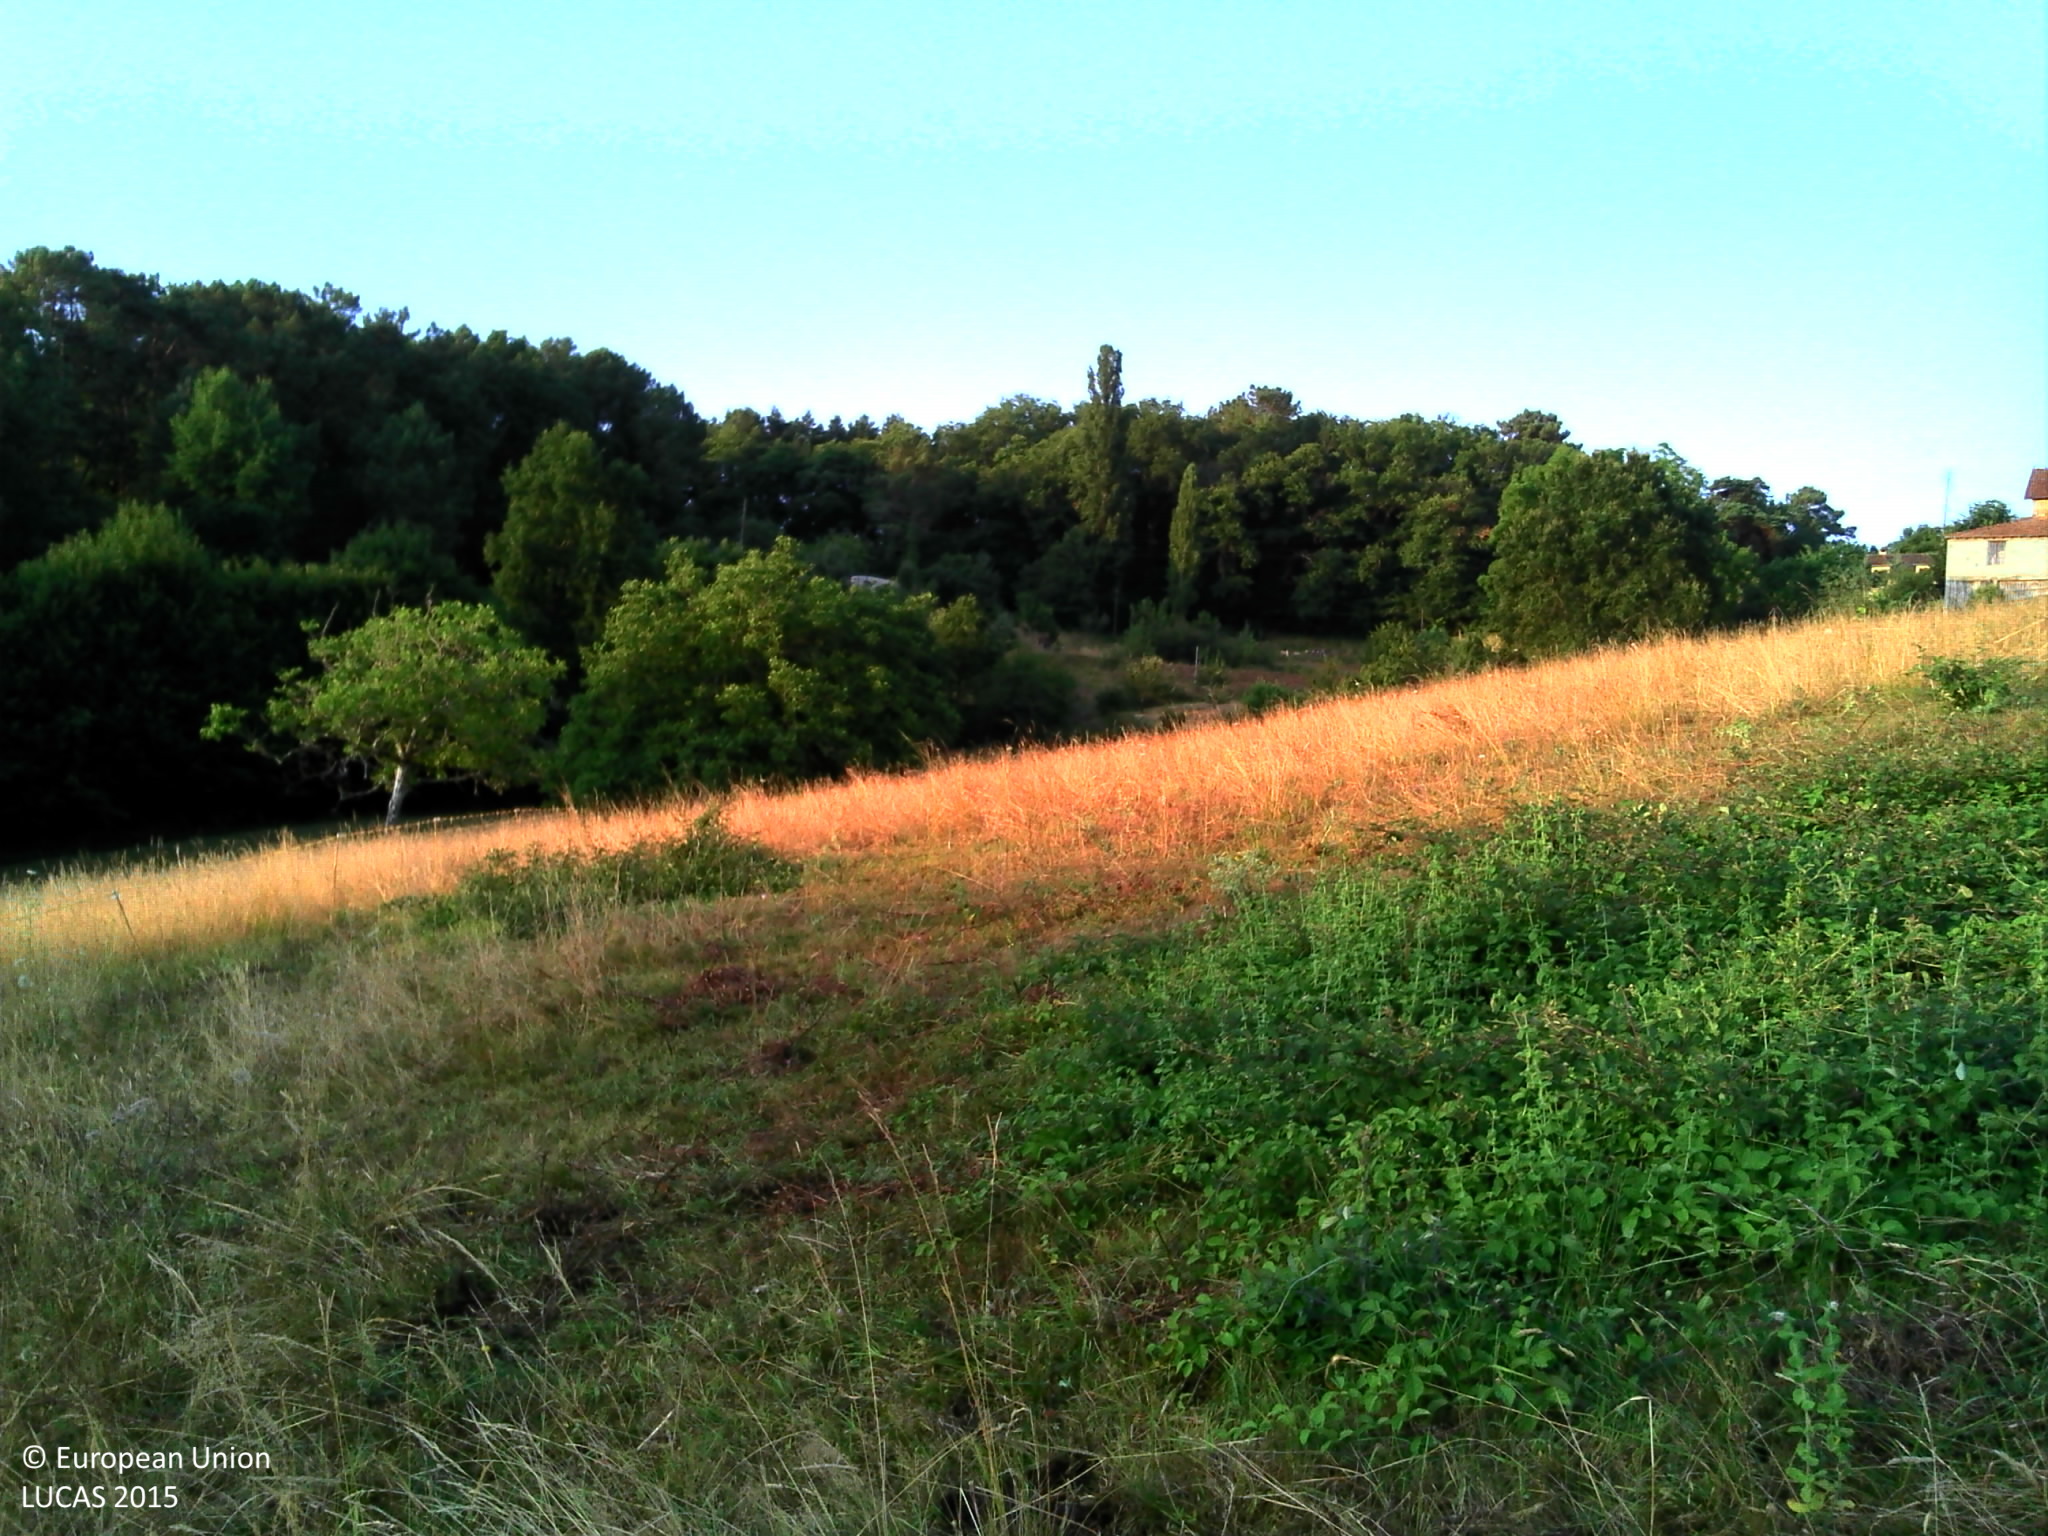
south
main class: Grassland
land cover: Grassland without tree/shrub cover
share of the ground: > 75 %
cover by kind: herbaceous plants 100 %
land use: Agriculture (excluding fallow land and kitchen gardens)
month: July
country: FR
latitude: 45.0769
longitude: 1.1395
